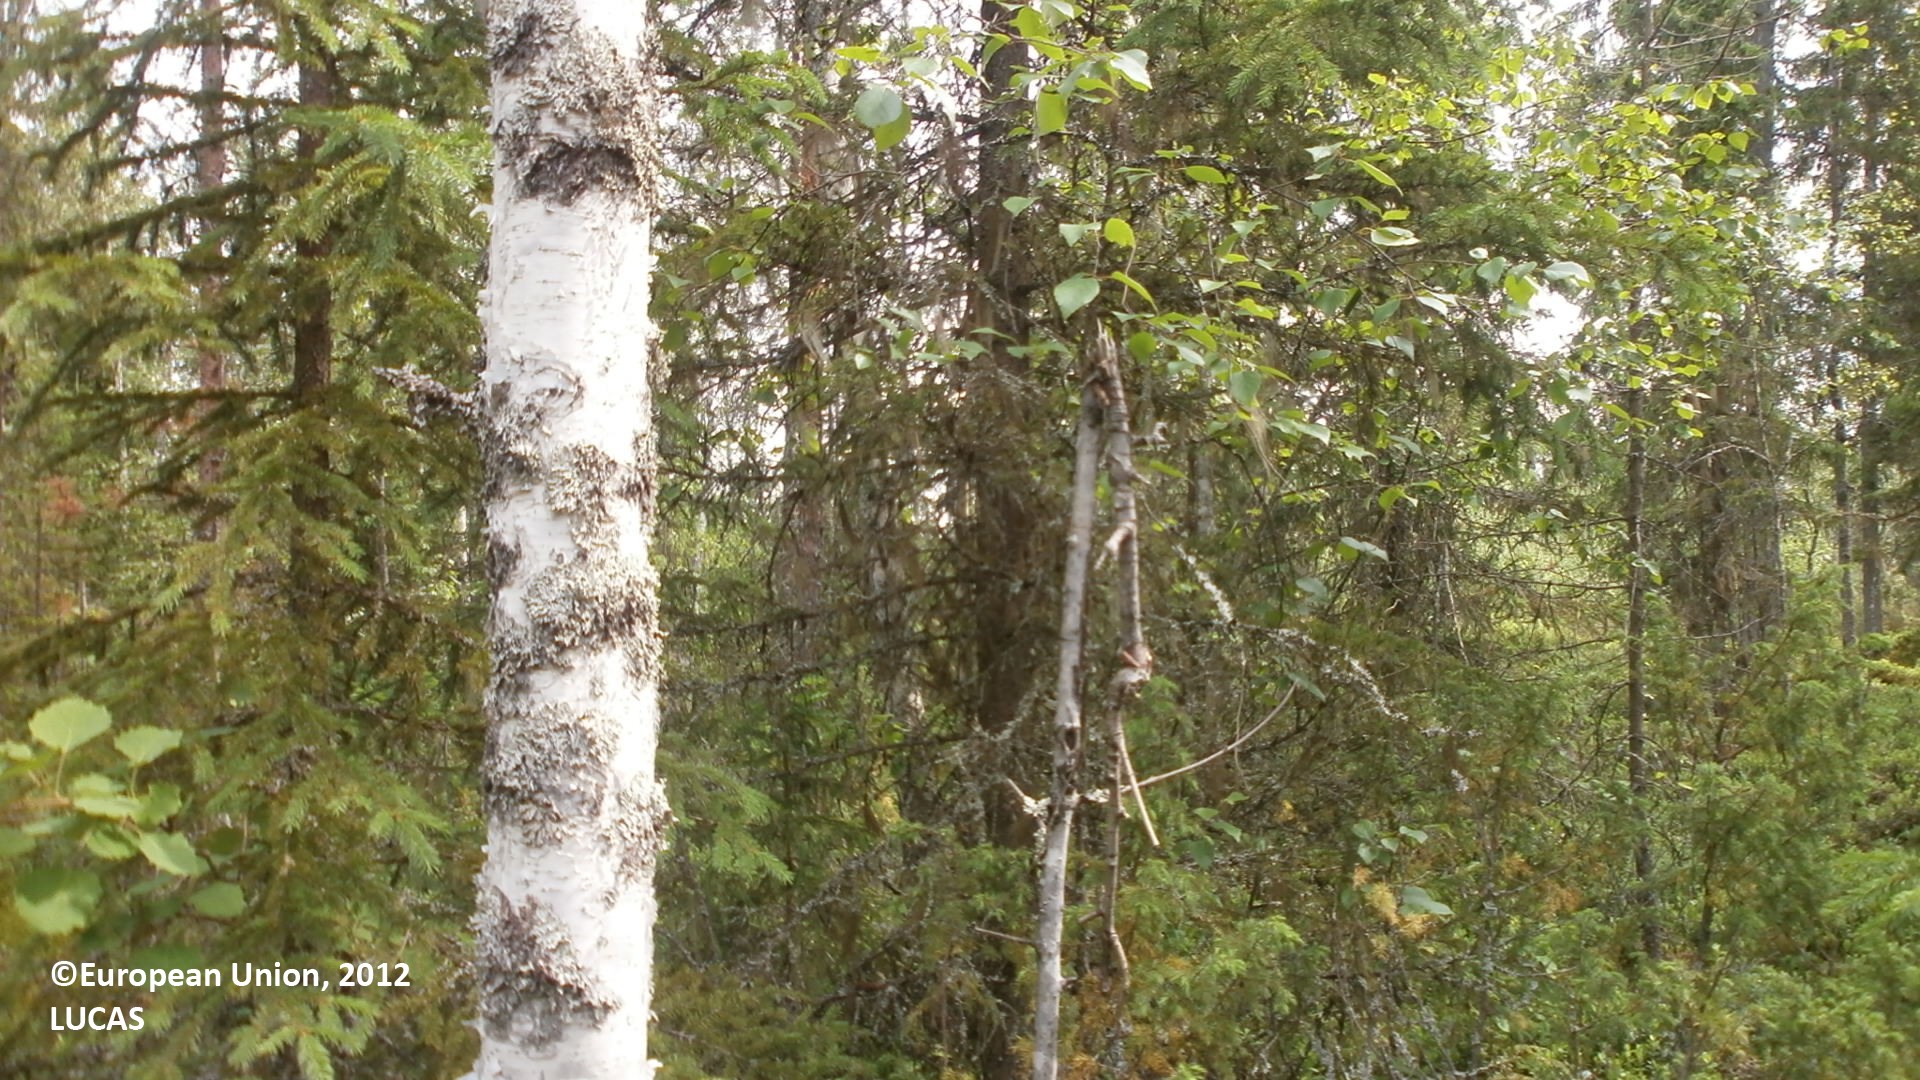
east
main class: Woodland
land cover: Spruce dominated mixed woodland
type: boreal forest
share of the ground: 50 - 75 %
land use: Forestry
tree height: > 5 m
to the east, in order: Spruce dominated mixed woodland; Pine dominated mixed woodland; Ditches and canals; Spruce dominated mixed woodland; Ditches and canals; Spruce dominated mixed woodland; Ditches and canals; Broadleaved woodland; Ditches and canals; Broadleaved woodland; Pine dominated mixed woodland; Ditches and canals; Pine dominated mixed woodland; Tracks; Pine dominated mixed woodland
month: July
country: FI
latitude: 64.0486
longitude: 24.8064
